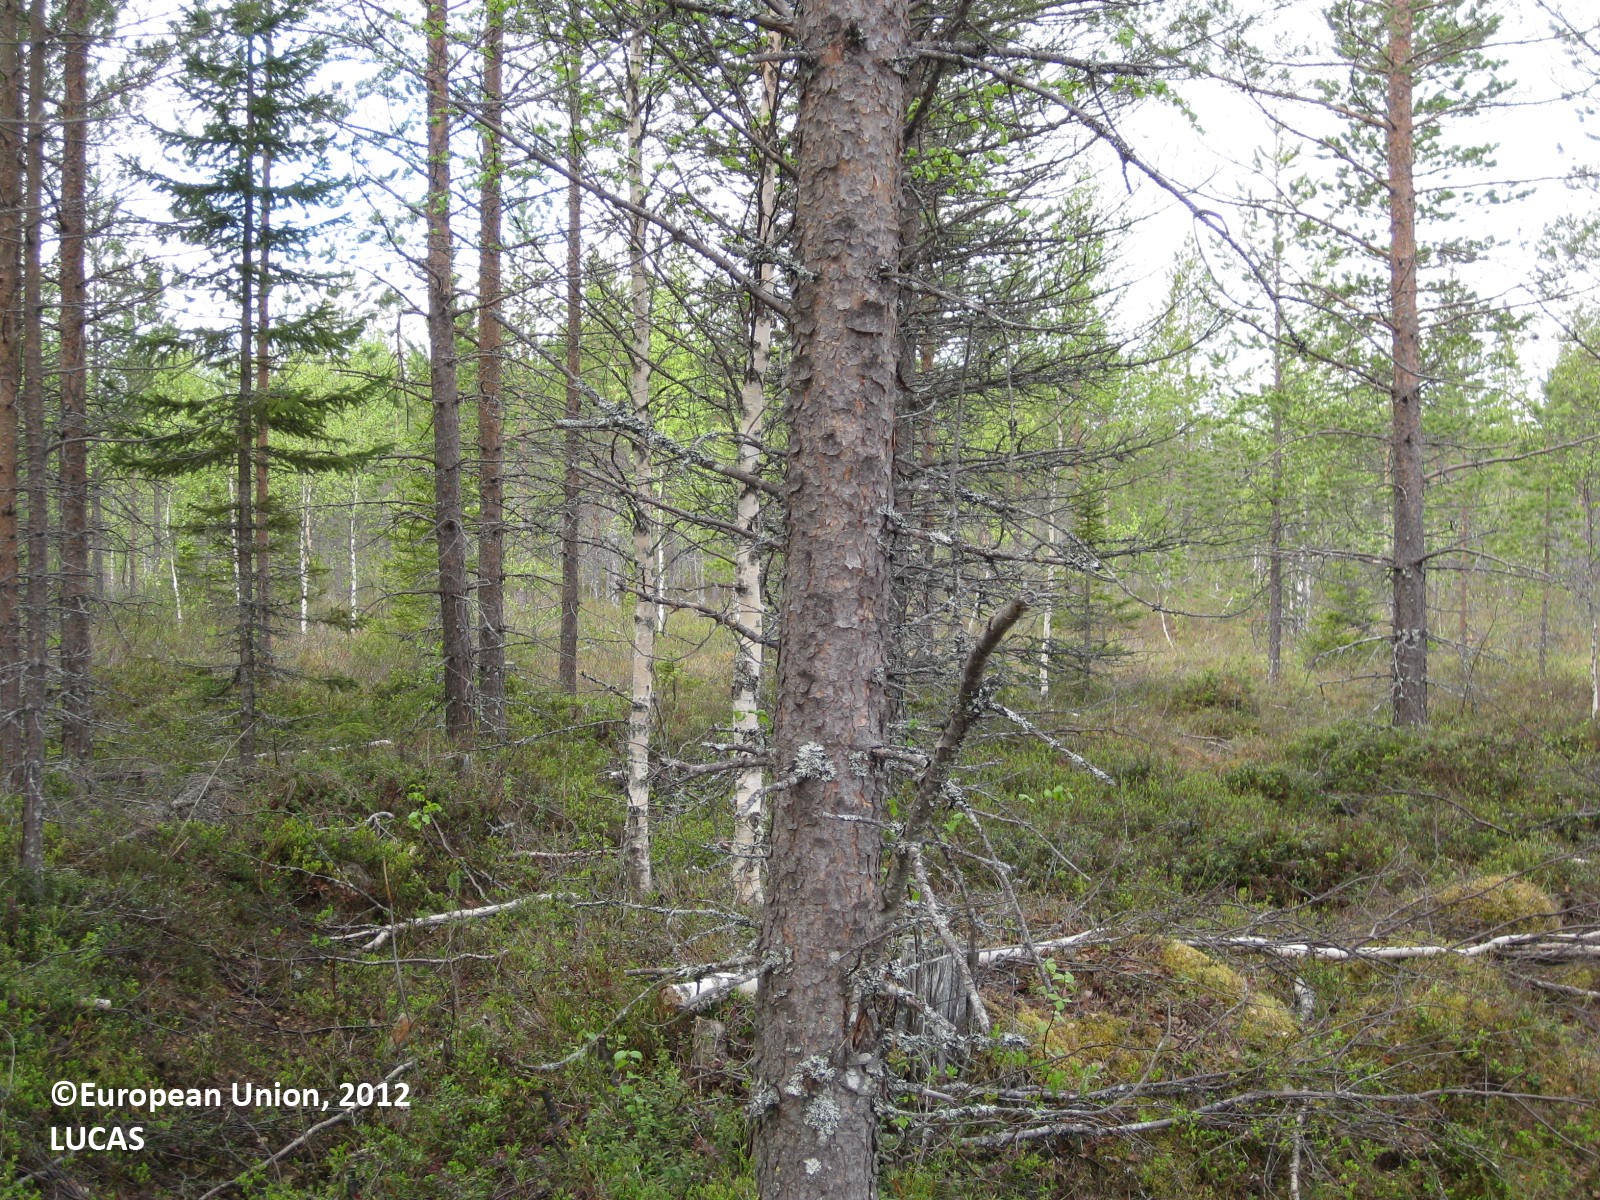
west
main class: Woodland
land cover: Pine dominated mixed woodland
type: boreal forest
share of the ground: > 75 %
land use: Forestry
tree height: > 5 m
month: June
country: FI
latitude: 65.0195
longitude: 29.5407
